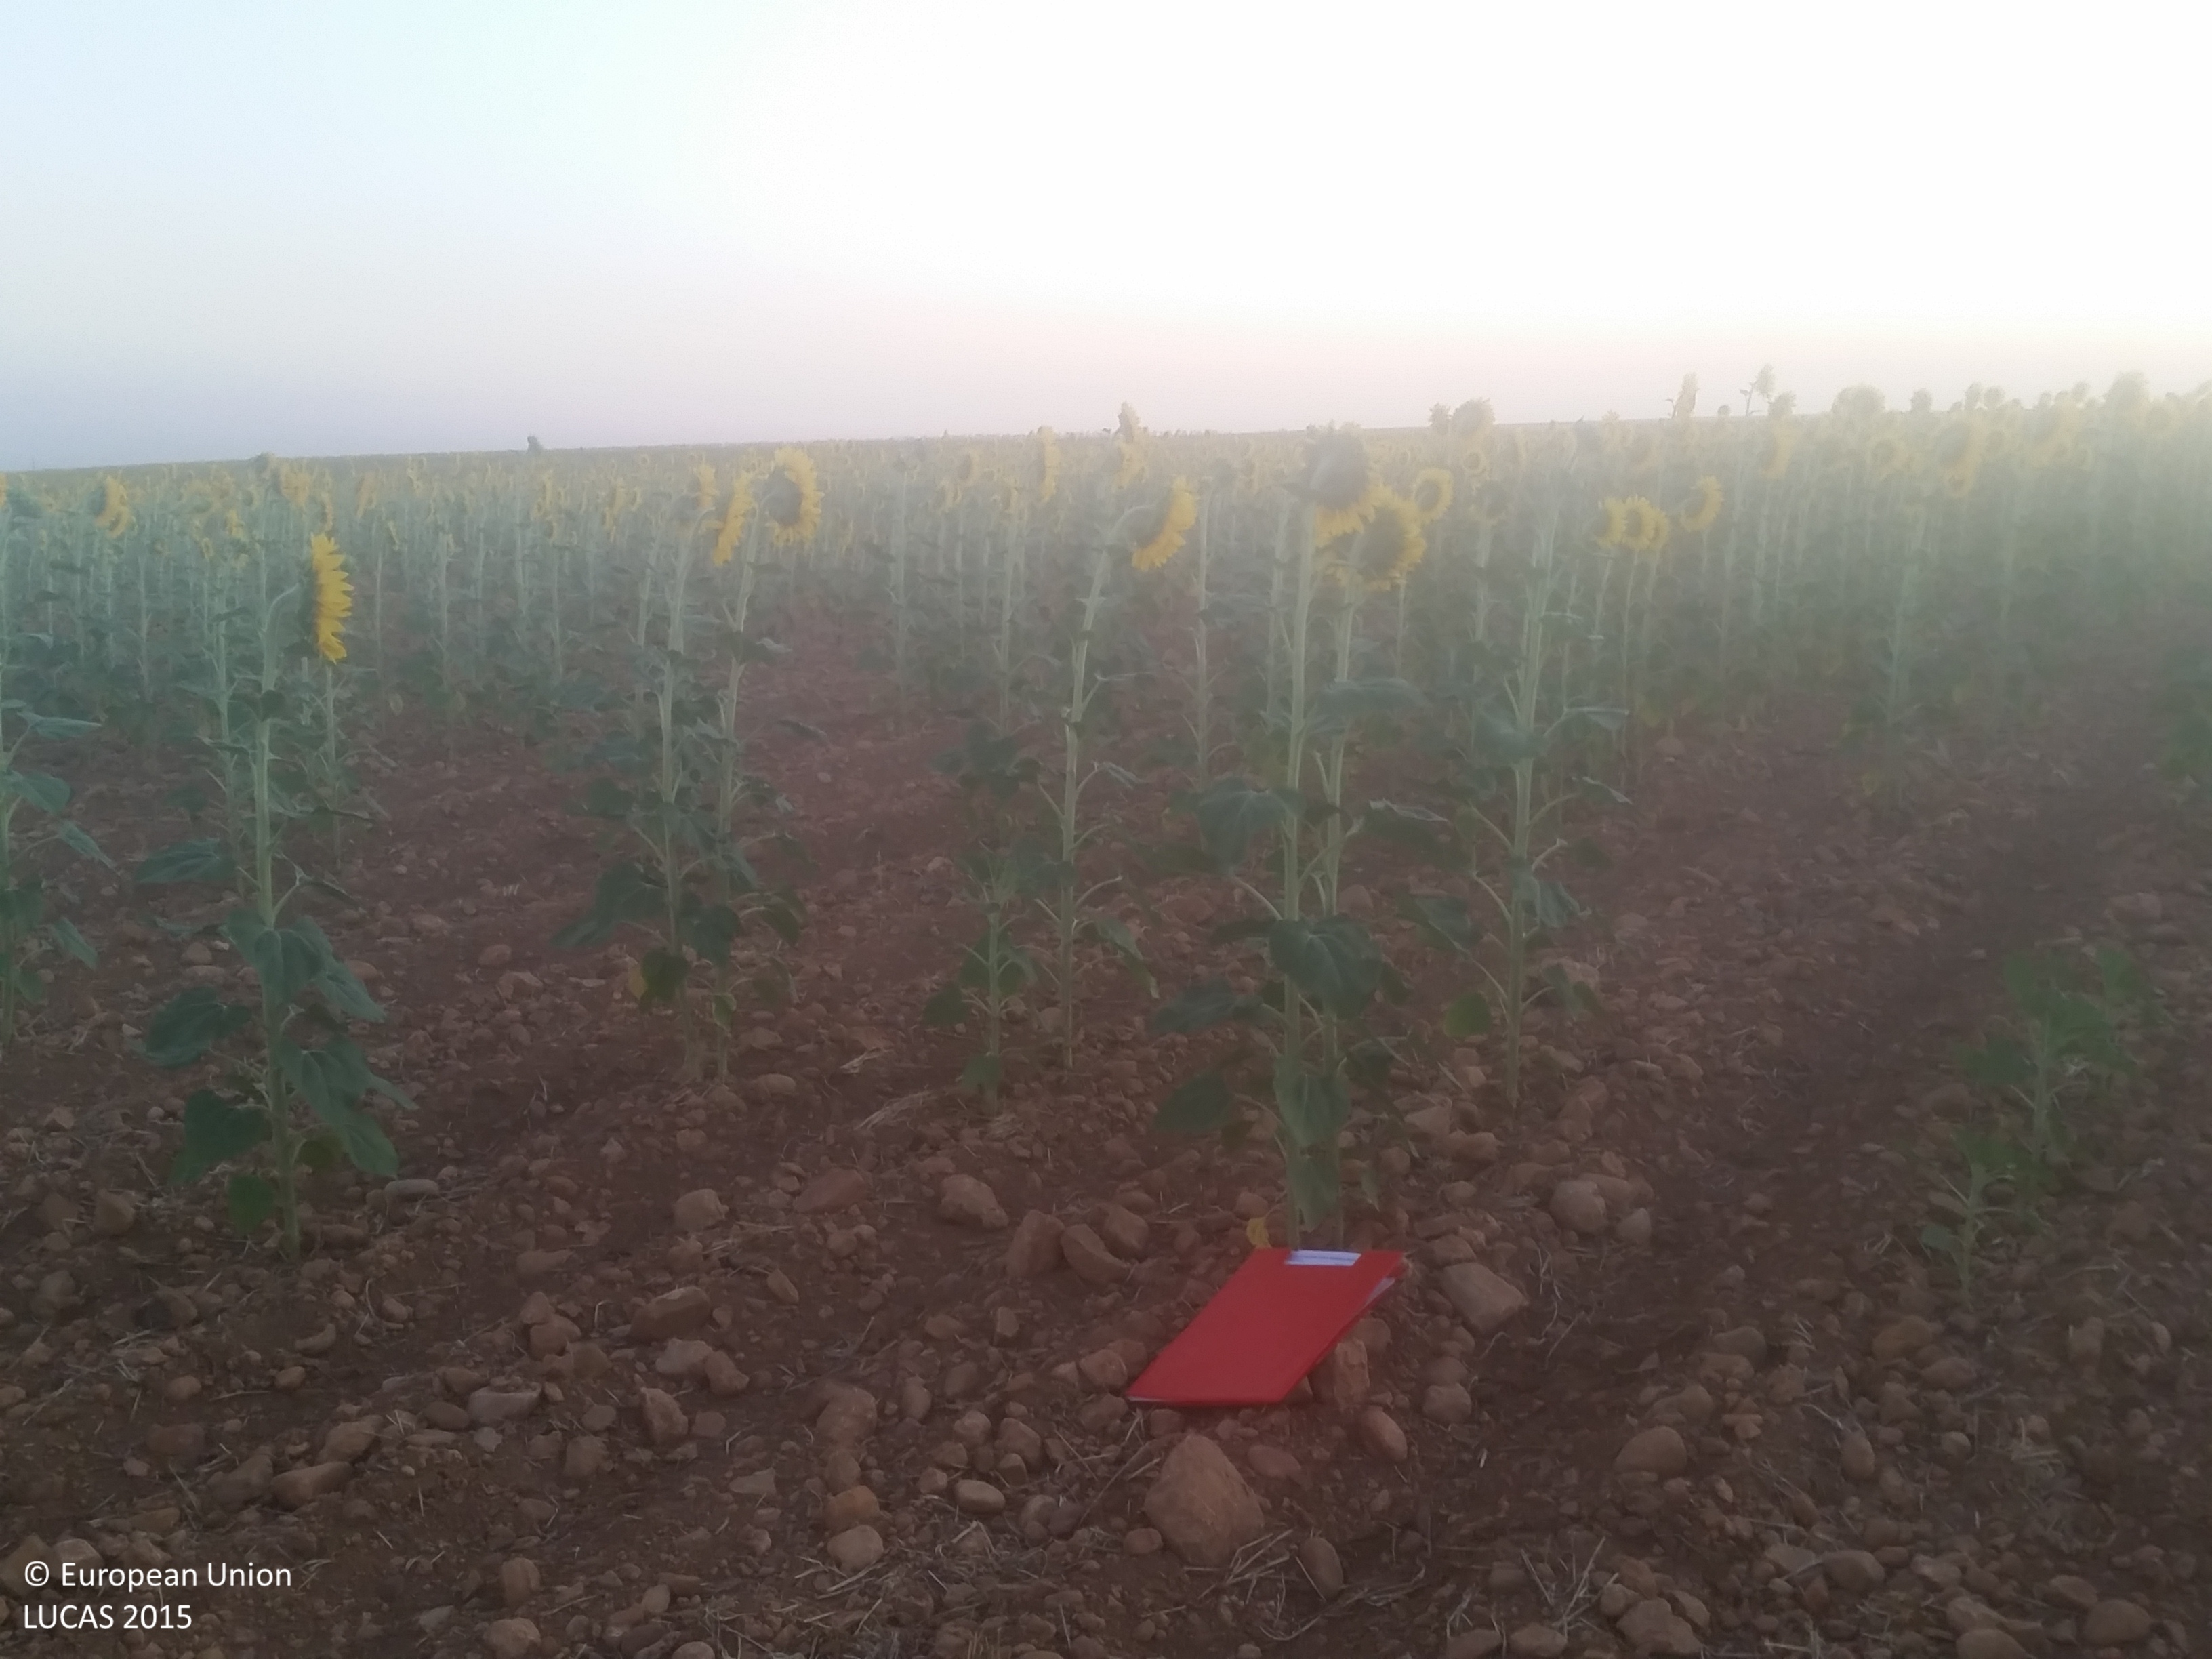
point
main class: Cropland
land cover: Sunflower
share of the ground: > 75 %
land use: Agriculture (excluding fallow land and kitchen gardens)
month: July
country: ES
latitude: 39.1365
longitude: -2.6303
